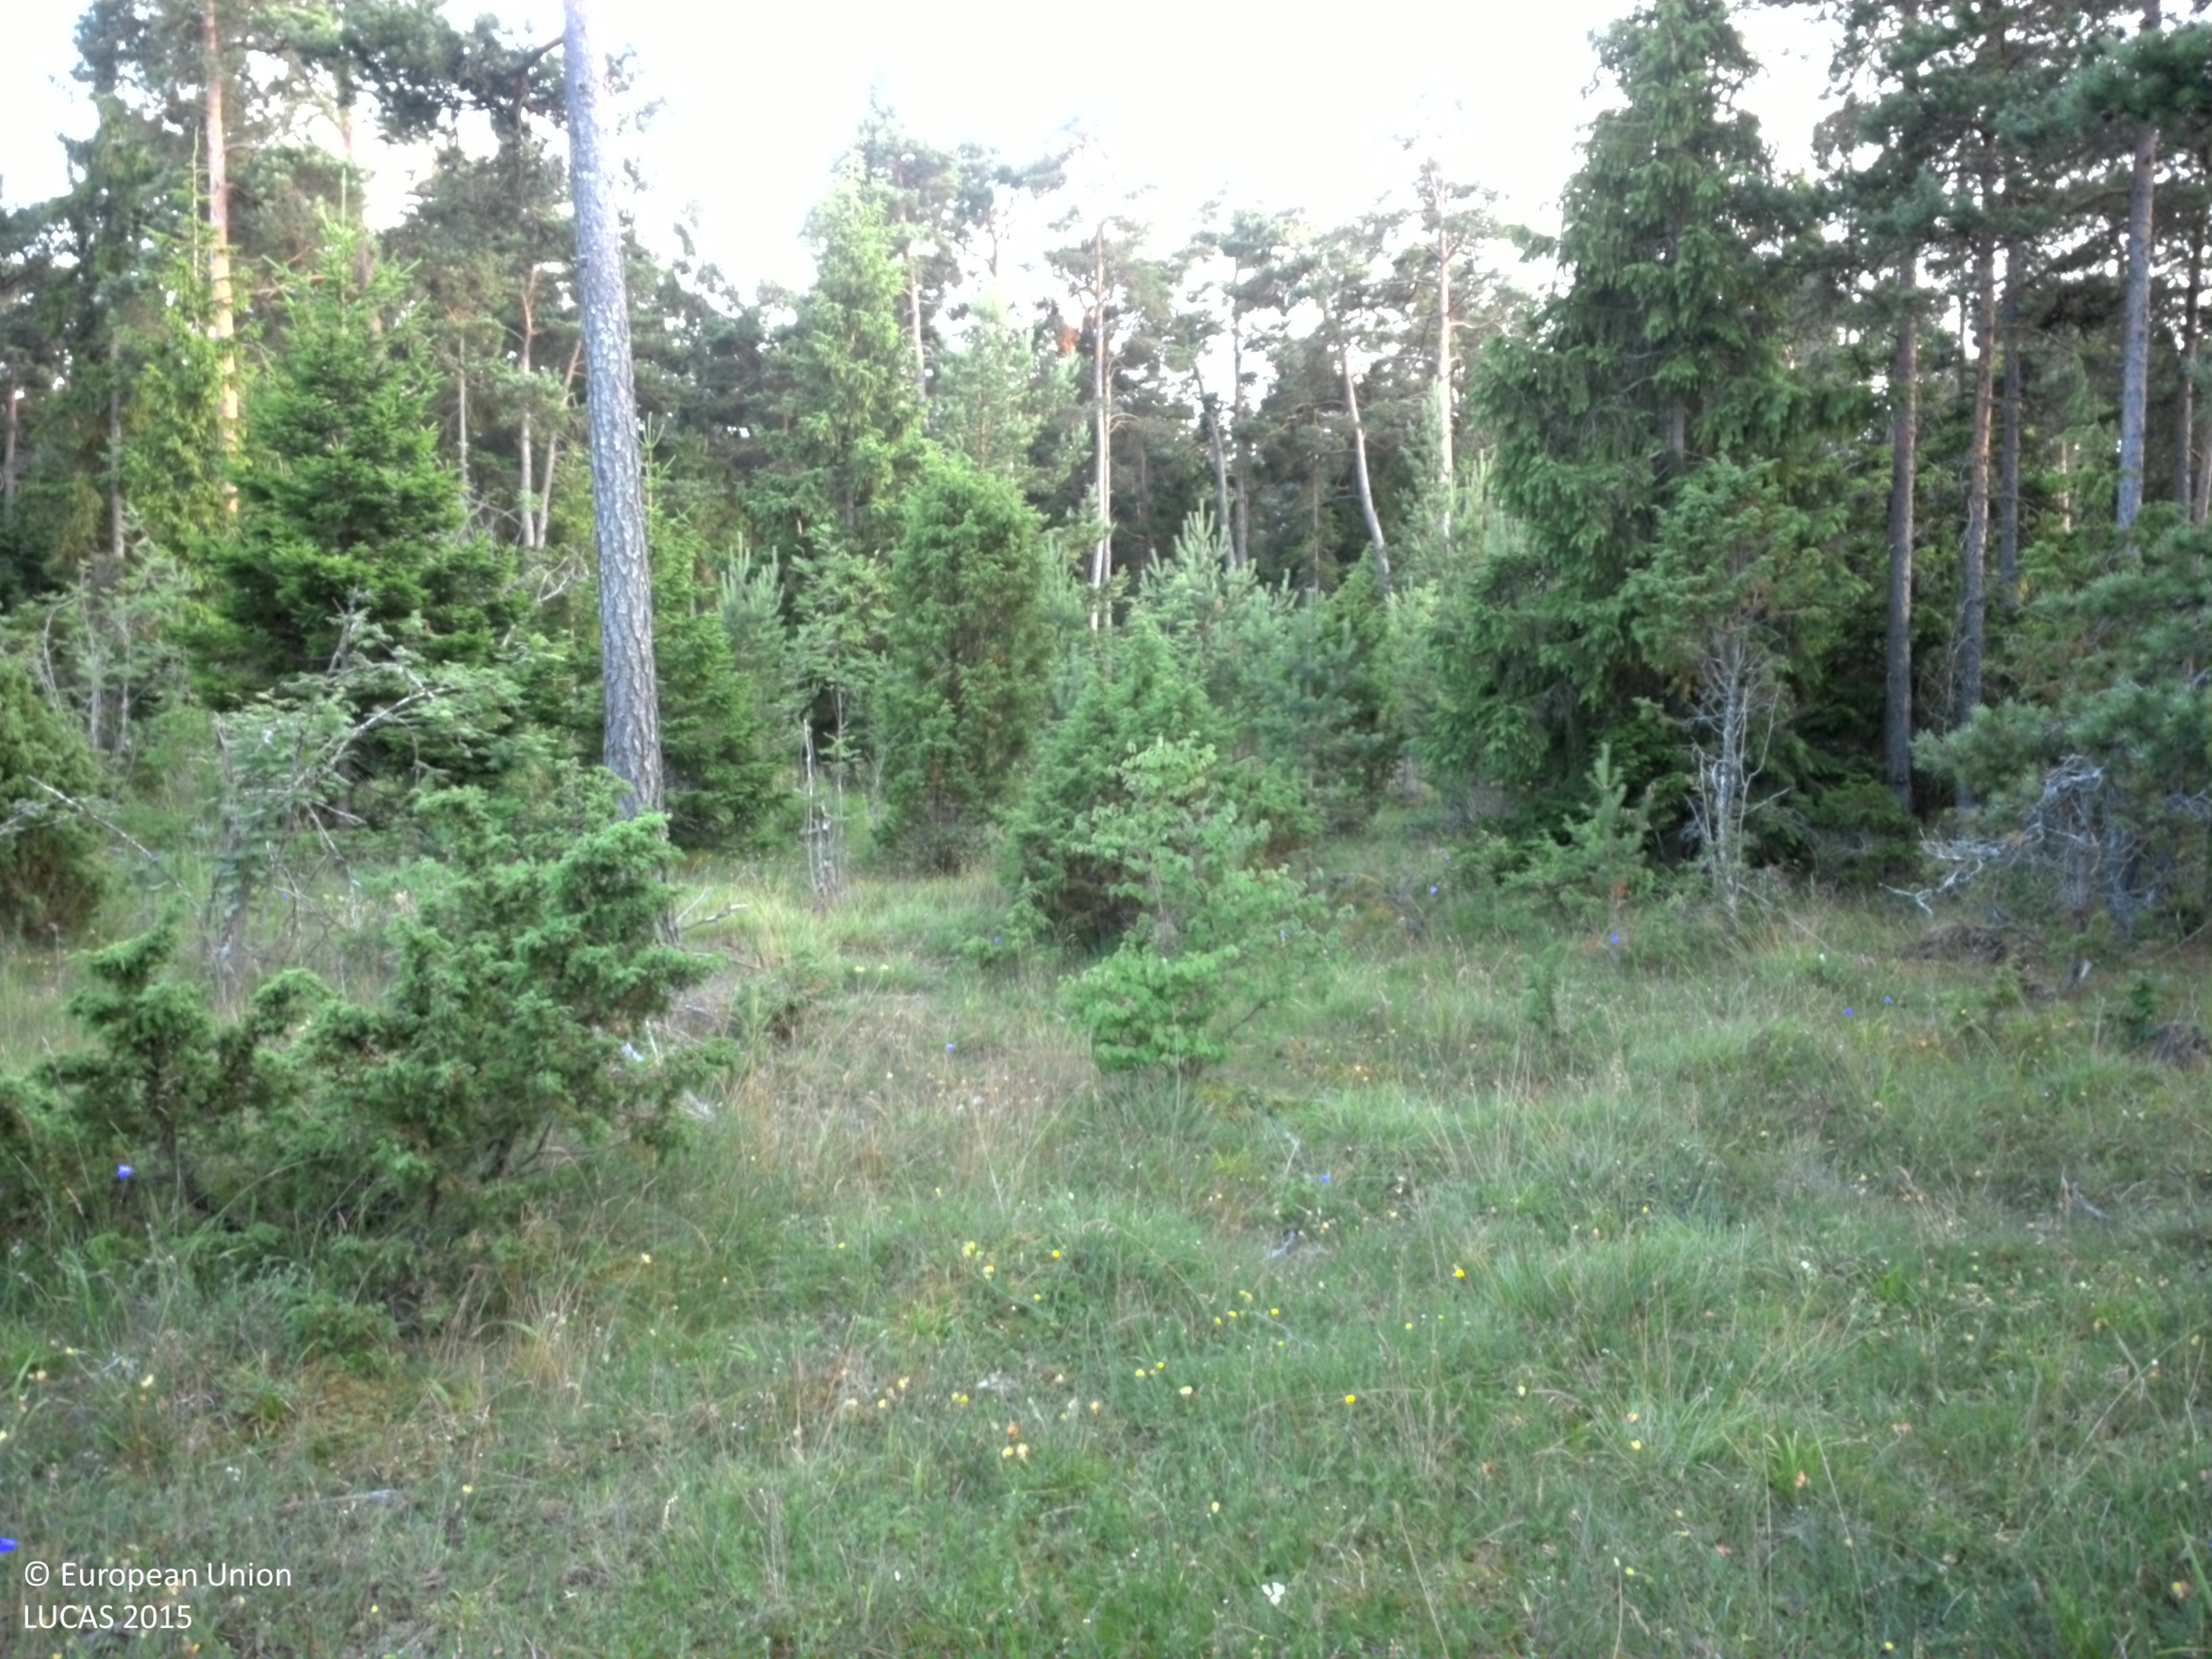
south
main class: Grassland
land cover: Grassland with sparse tree/shrub cover
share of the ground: > 75 %
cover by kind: herbaceous plants 90 %, coniferous forest trees 5 %, shrubs 5 %
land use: Semi-natural and natural areas not in use
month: July
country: SE
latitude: 57.5893
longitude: 18.7589
